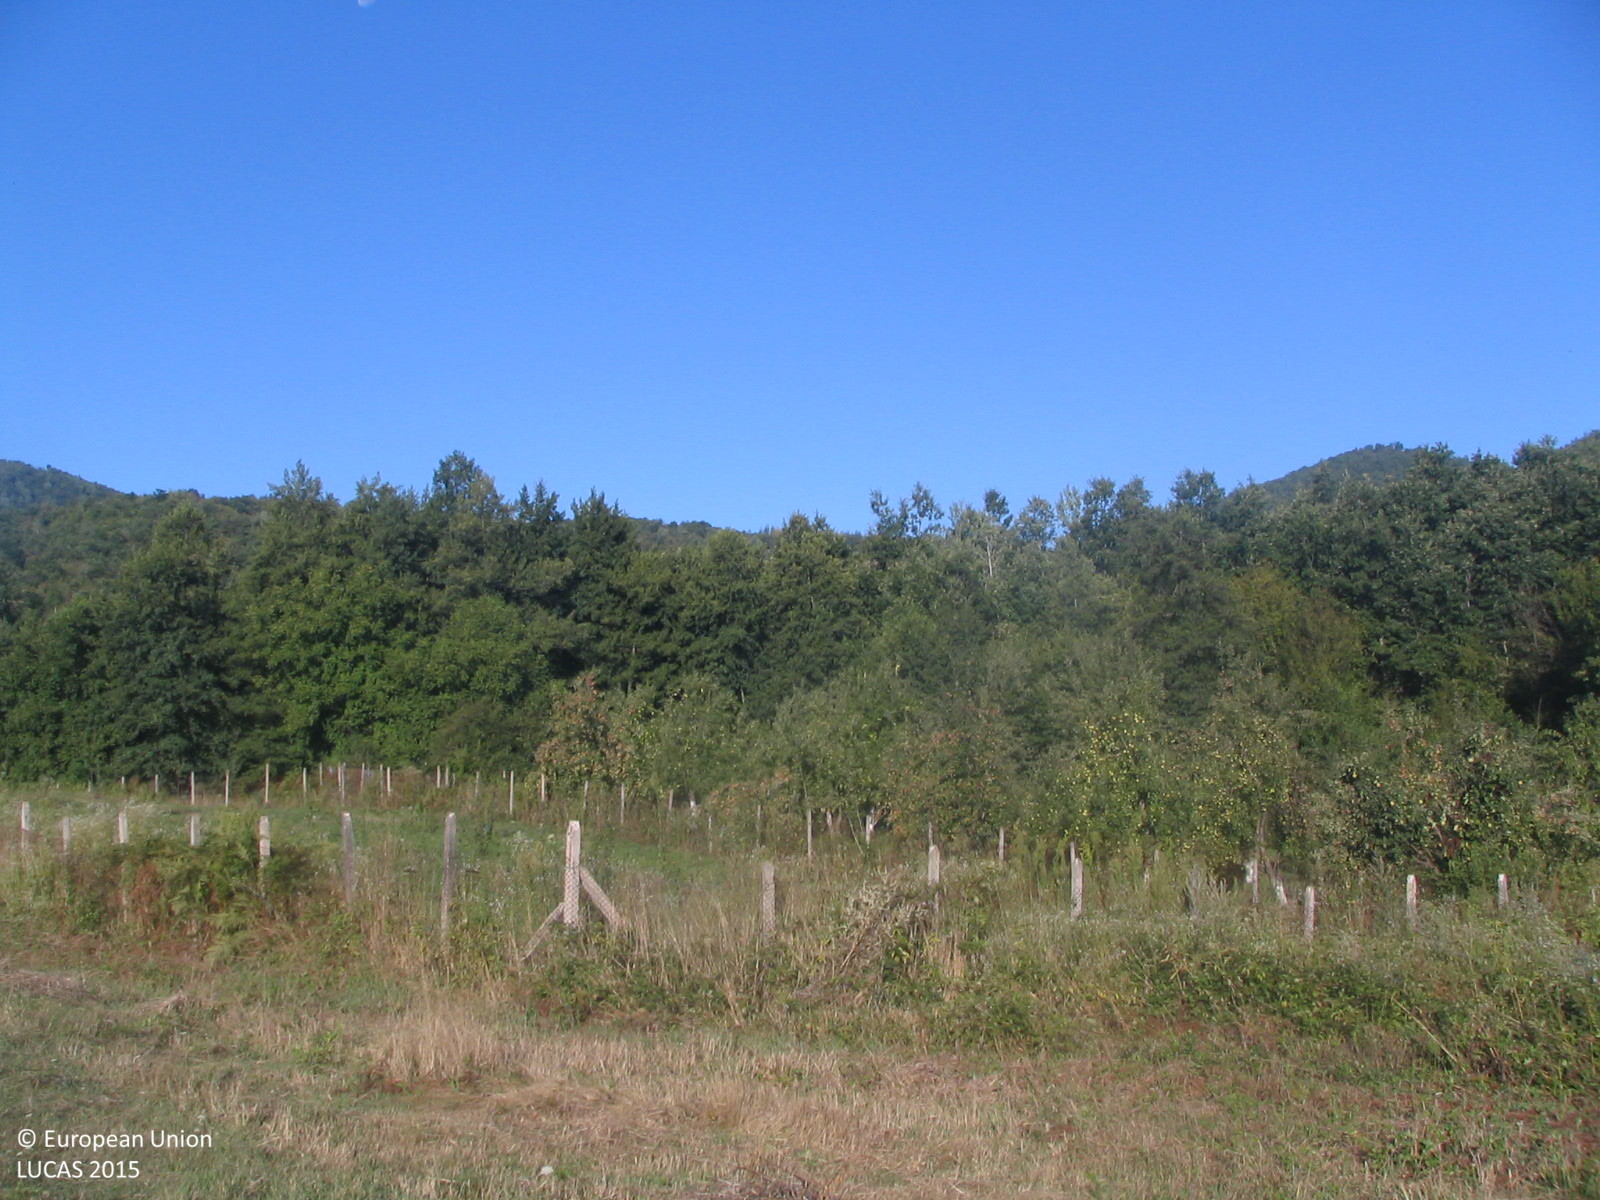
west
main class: Woodland
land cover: Broadleaved woodland
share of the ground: 50 - 75 %
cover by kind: broadleaved forest trees 60 %, shrubs 25 %, herbaceous plants 15 %
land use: Abandoned areas
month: September
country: BG
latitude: 42.9579
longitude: 24.3840
